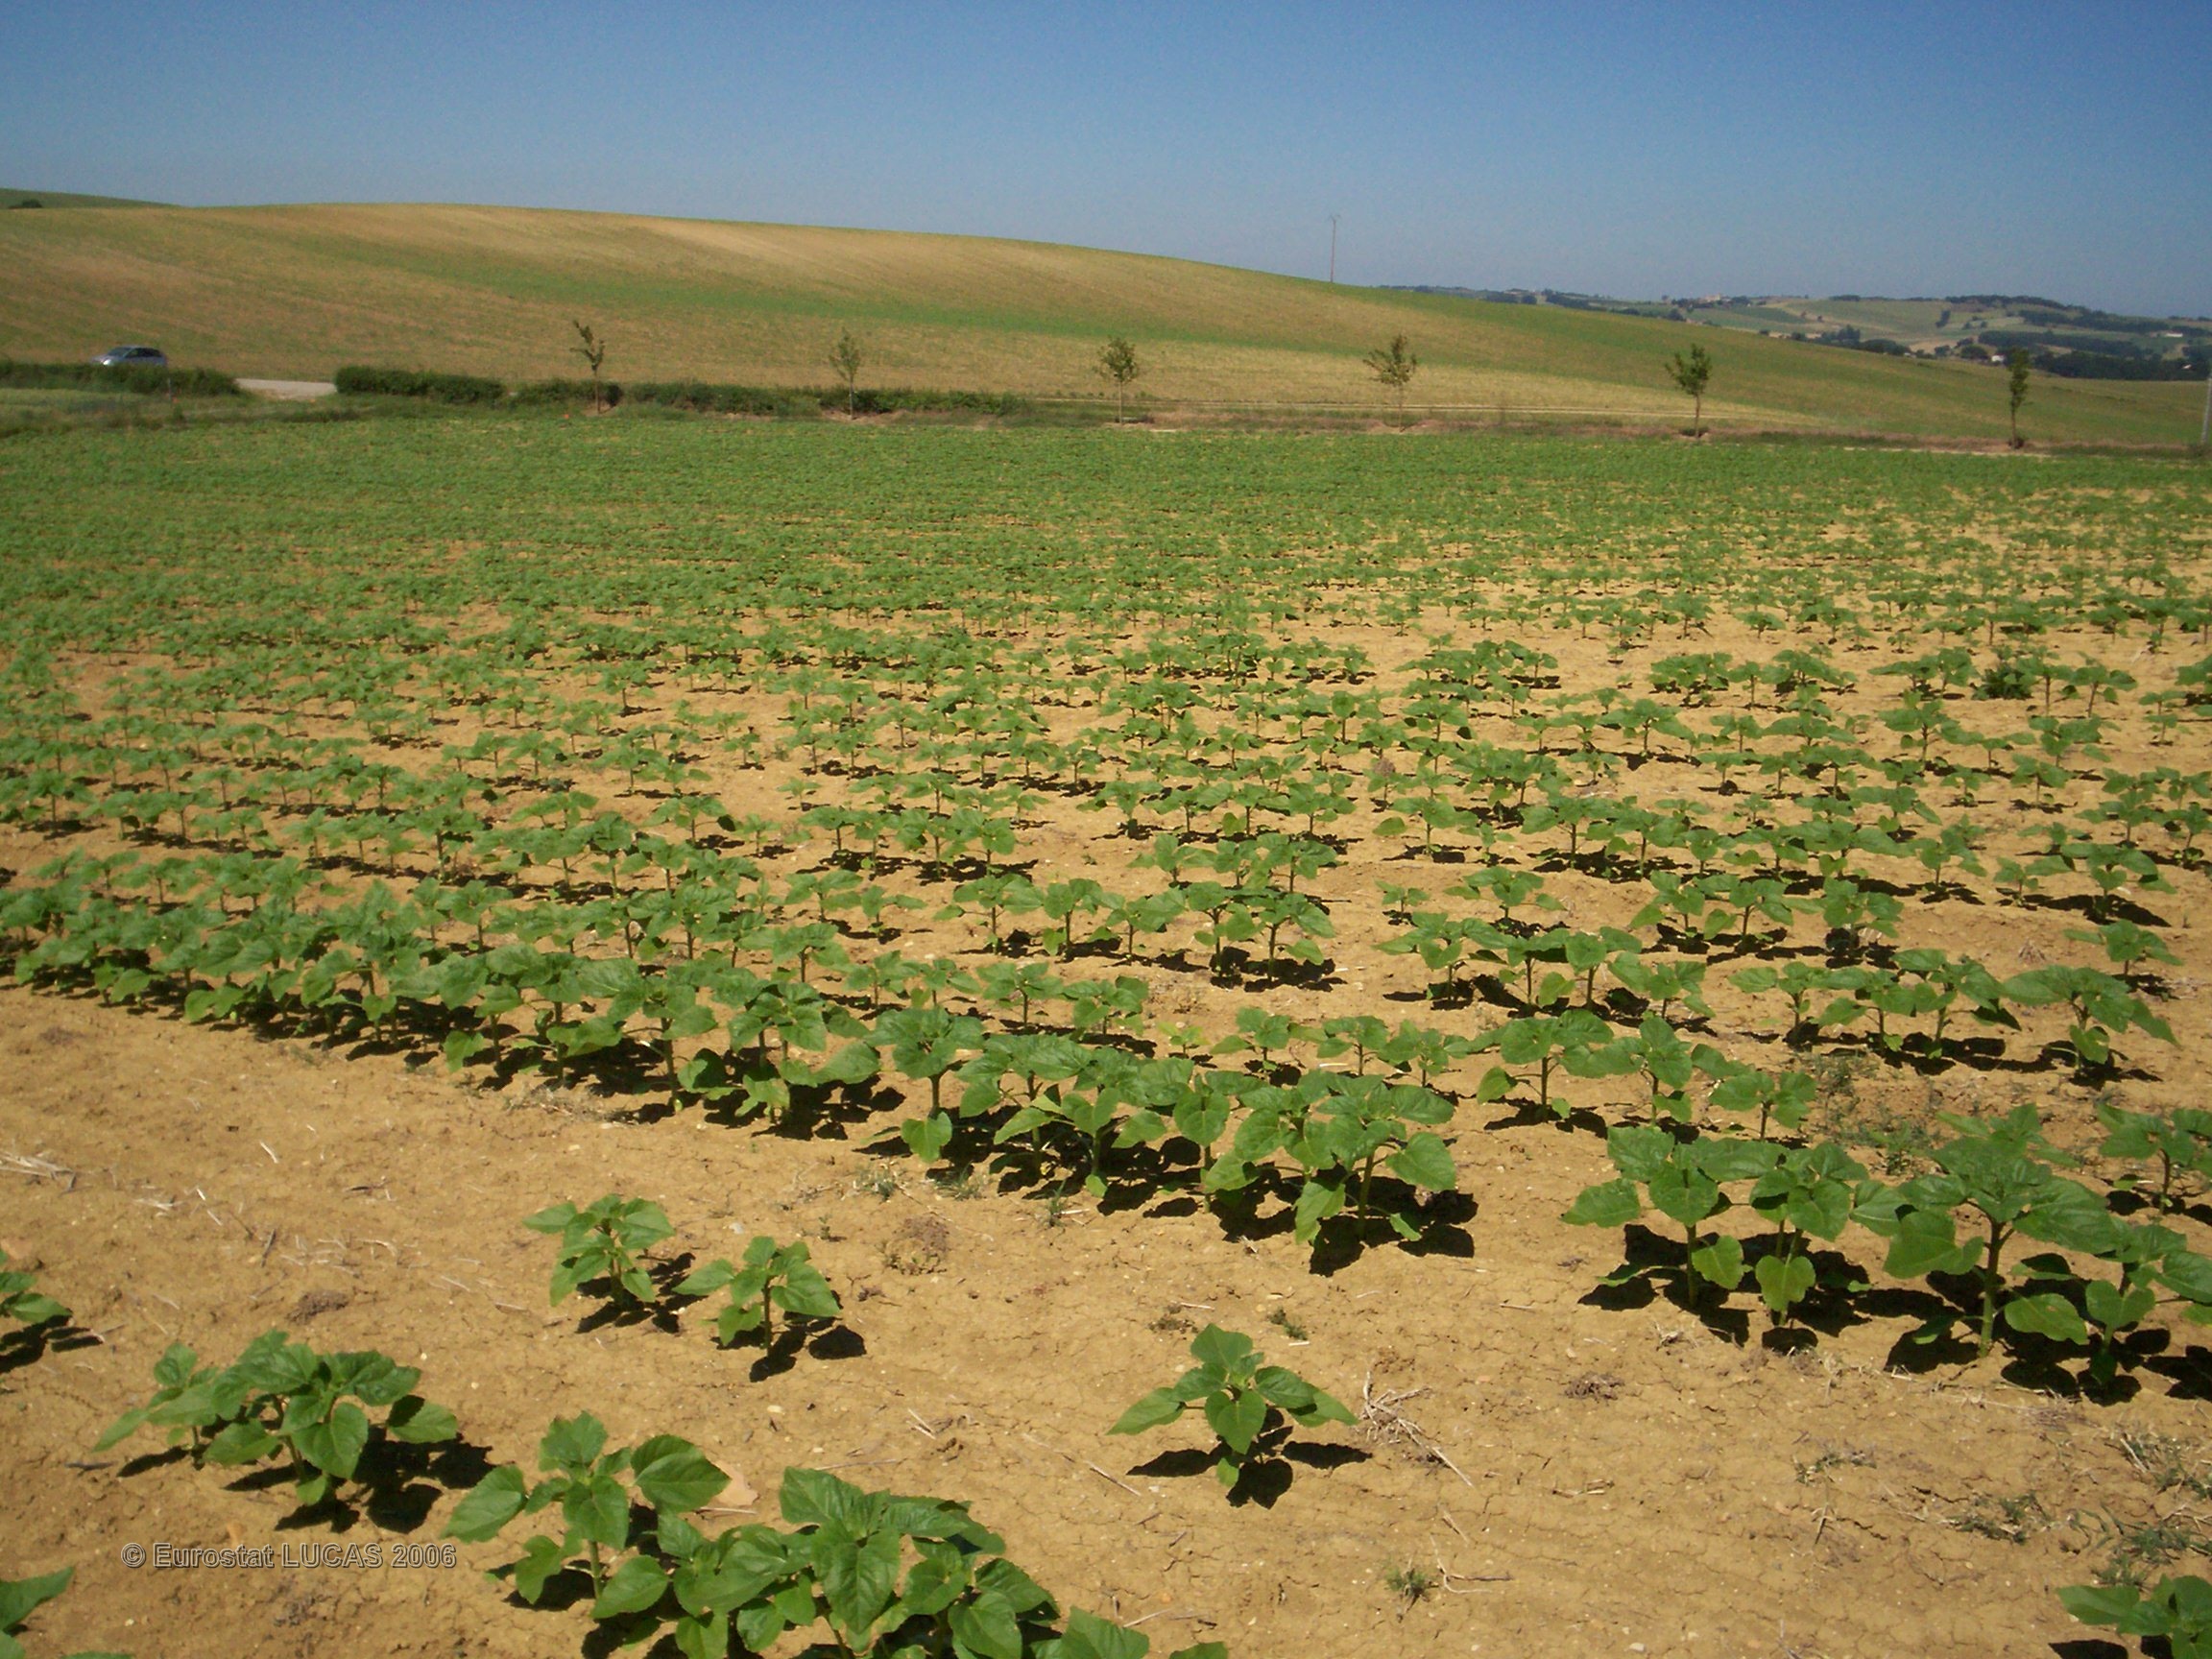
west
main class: Cropland
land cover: Sunflower
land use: Agriculture (excluding fallow land and kitchen gardens)
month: June
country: FR
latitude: 44.0118
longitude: 0.7789
